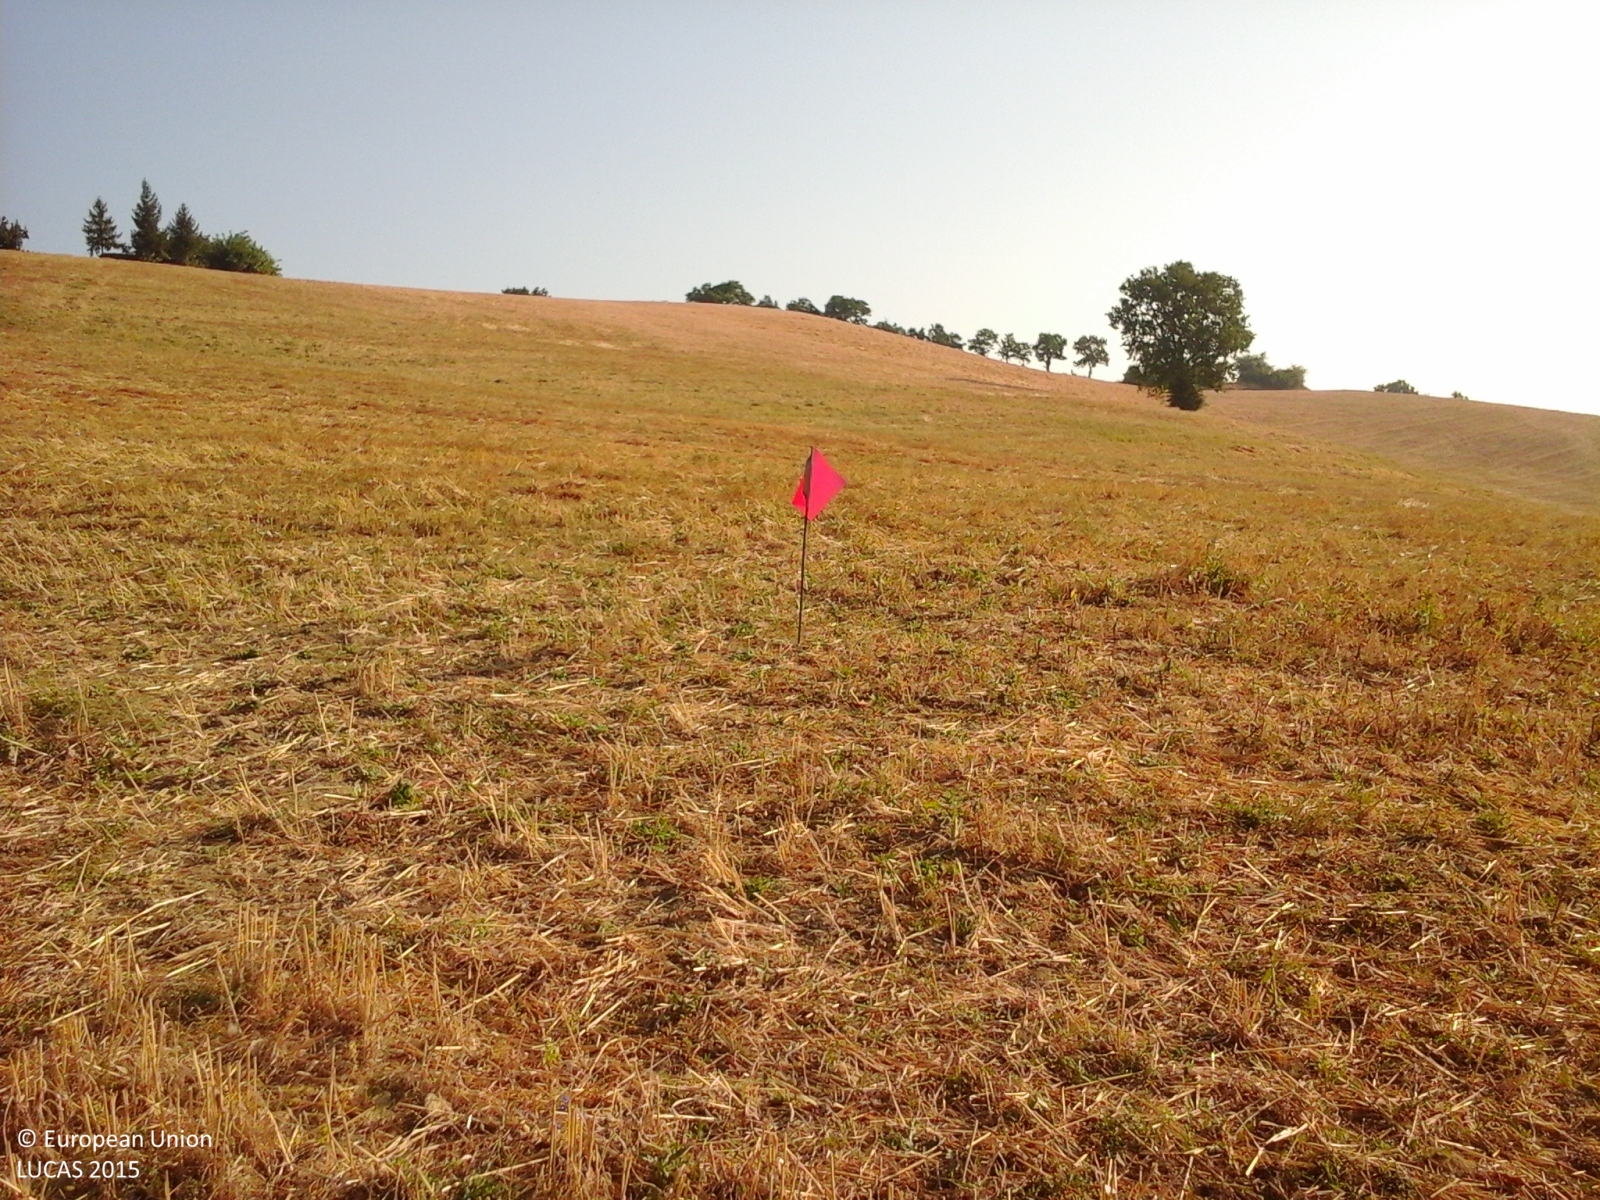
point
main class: Cropland
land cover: Common wheat
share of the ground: < 10 %
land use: Agriculture (excluding fallow land and kitchen gardens)
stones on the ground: < 10 %
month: August
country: IT
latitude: 43.6506
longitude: 12.5847
